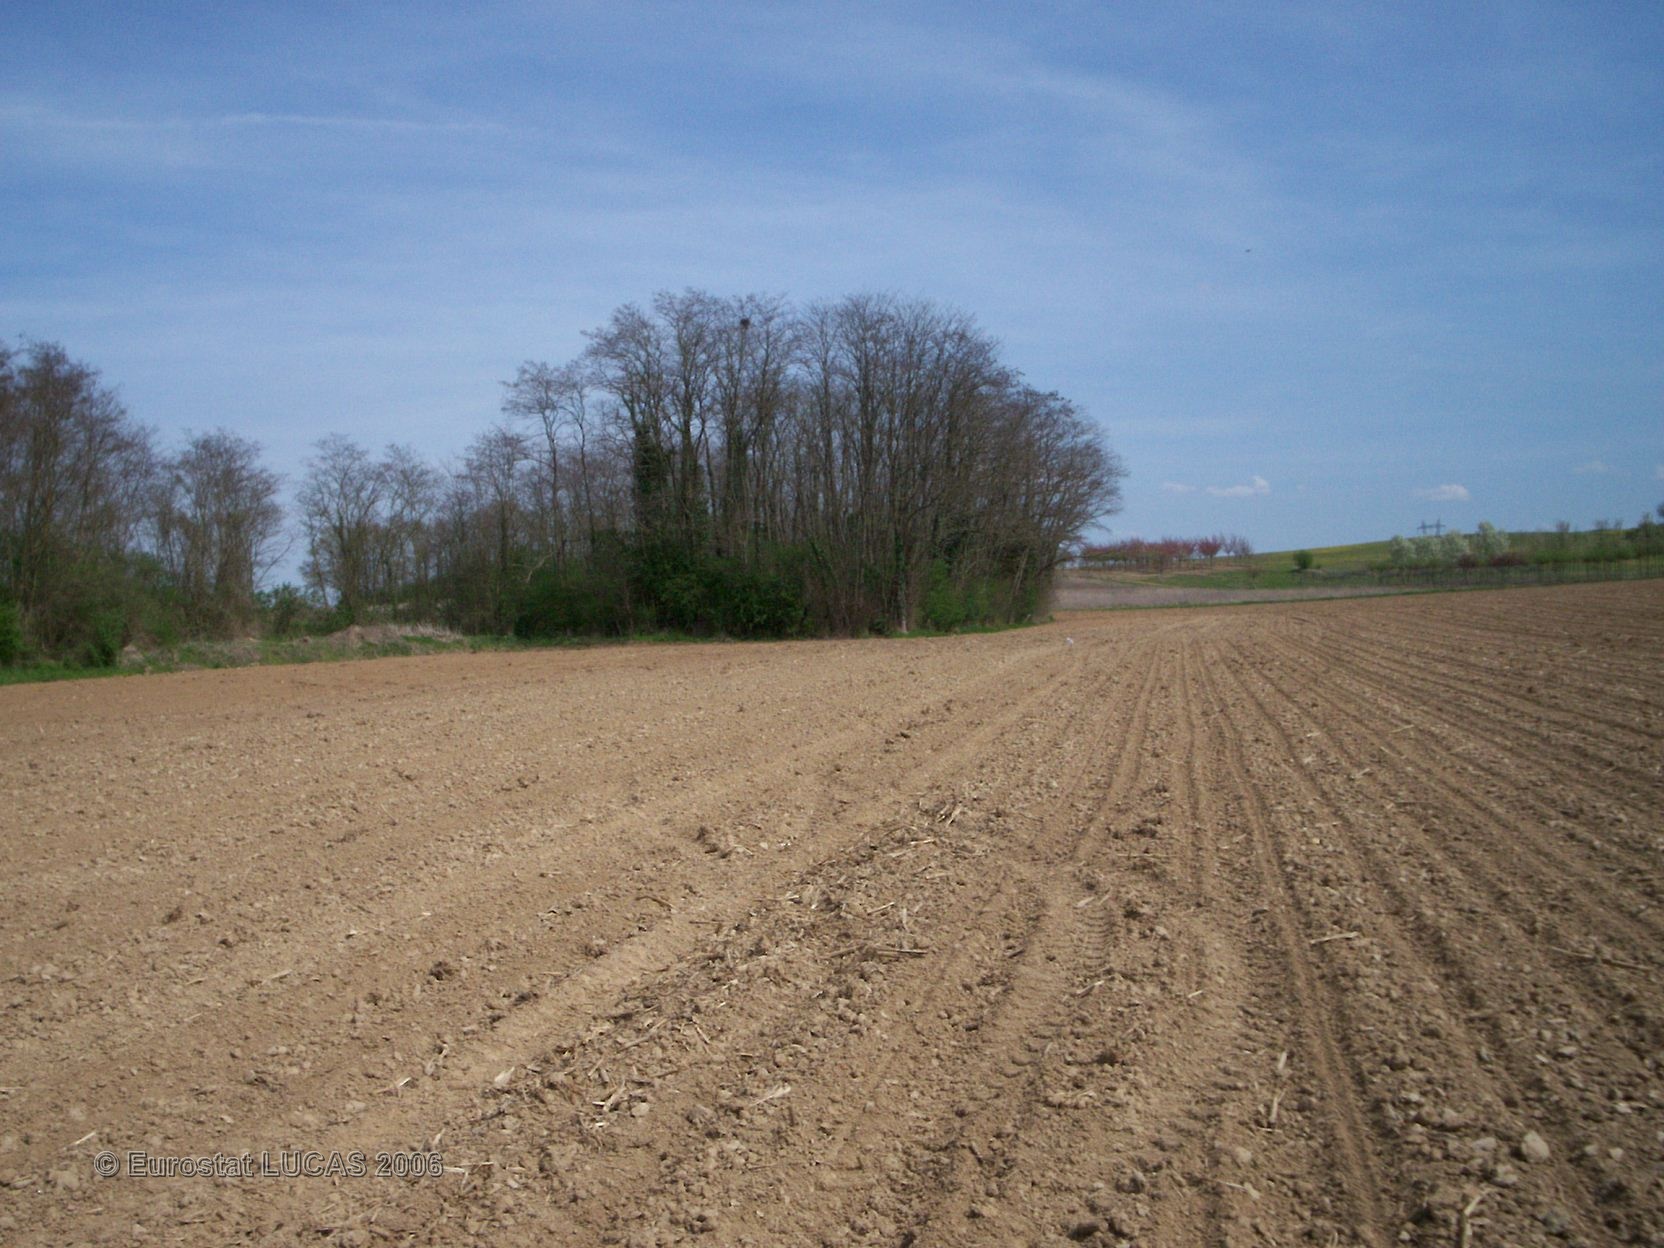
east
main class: Cropland
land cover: Sugar beet
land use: Agriculture (excluding fallow land and kitchen gardens)
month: April
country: FR
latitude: 48.3400
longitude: 2.9359
